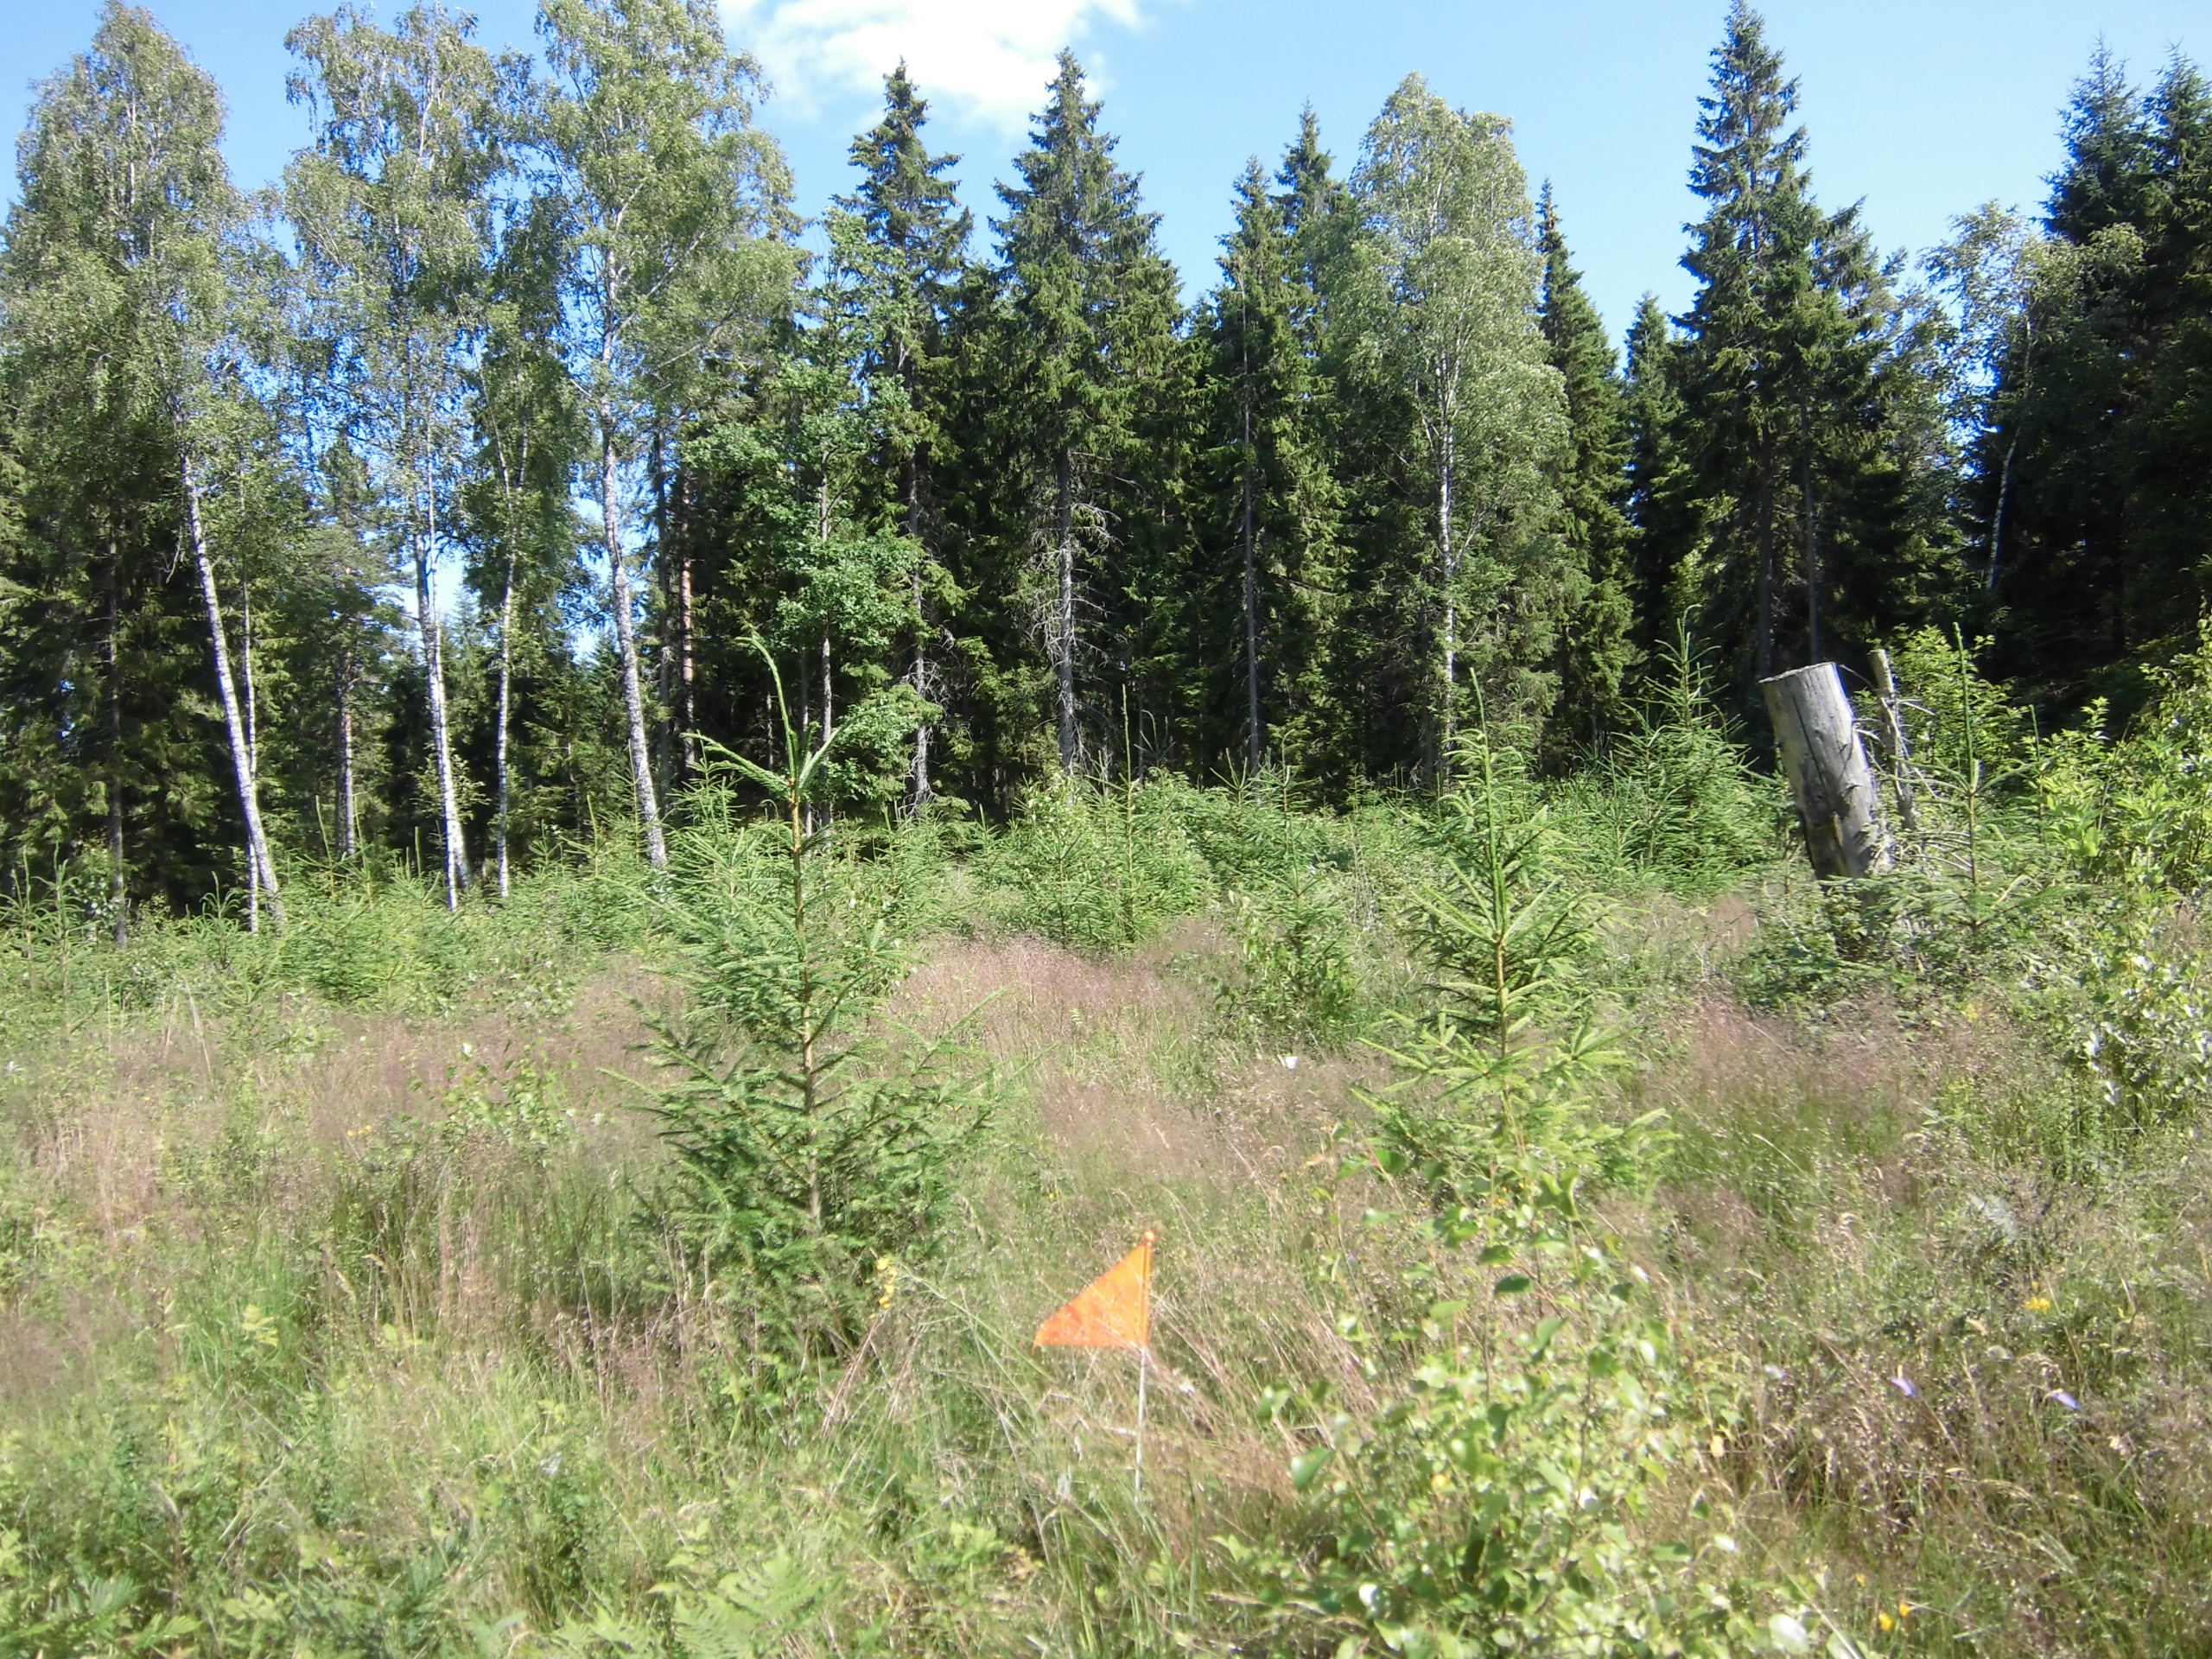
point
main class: Woodland
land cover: Spruce dominated mixed woodland
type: boreal forest
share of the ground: 25 - 50 %
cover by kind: herbaceous plants 35 %, shrubs 30 %, coniferous forest trees 15 %, broadleaved forest trees 15 %, lichens and mosses 5 %
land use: Forestry
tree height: < 5 m
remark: Clear cut
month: July
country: SE
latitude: 57.2822
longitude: 15.3884
